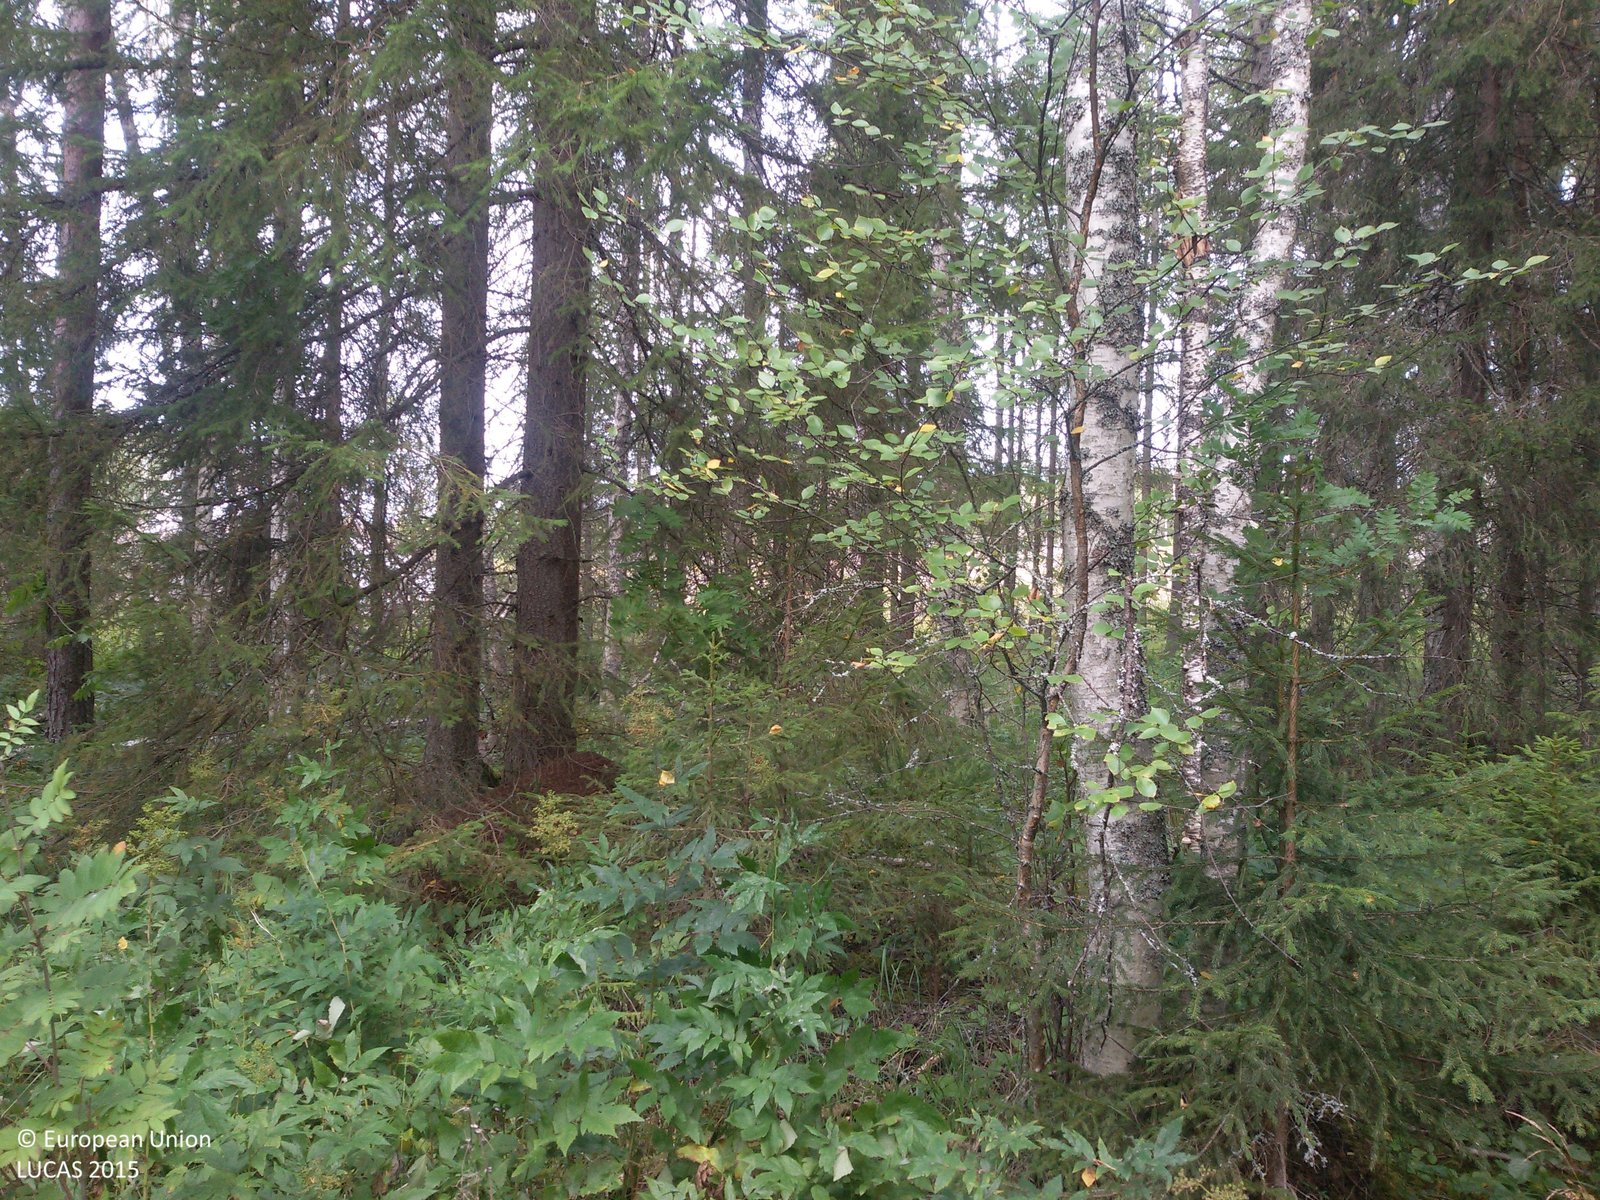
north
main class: Woodland
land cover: Spruce dominated mixed woodland
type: boreal forest
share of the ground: > 75 %
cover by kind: coniferous forest trees 60 %, broadleaved forest trees 20 %, herbaceous plants 10 %, lichens and mosses 10 %
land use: Forestry
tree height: > 5 m
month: September
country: SE
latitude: 60.9136
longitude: 15.2419
